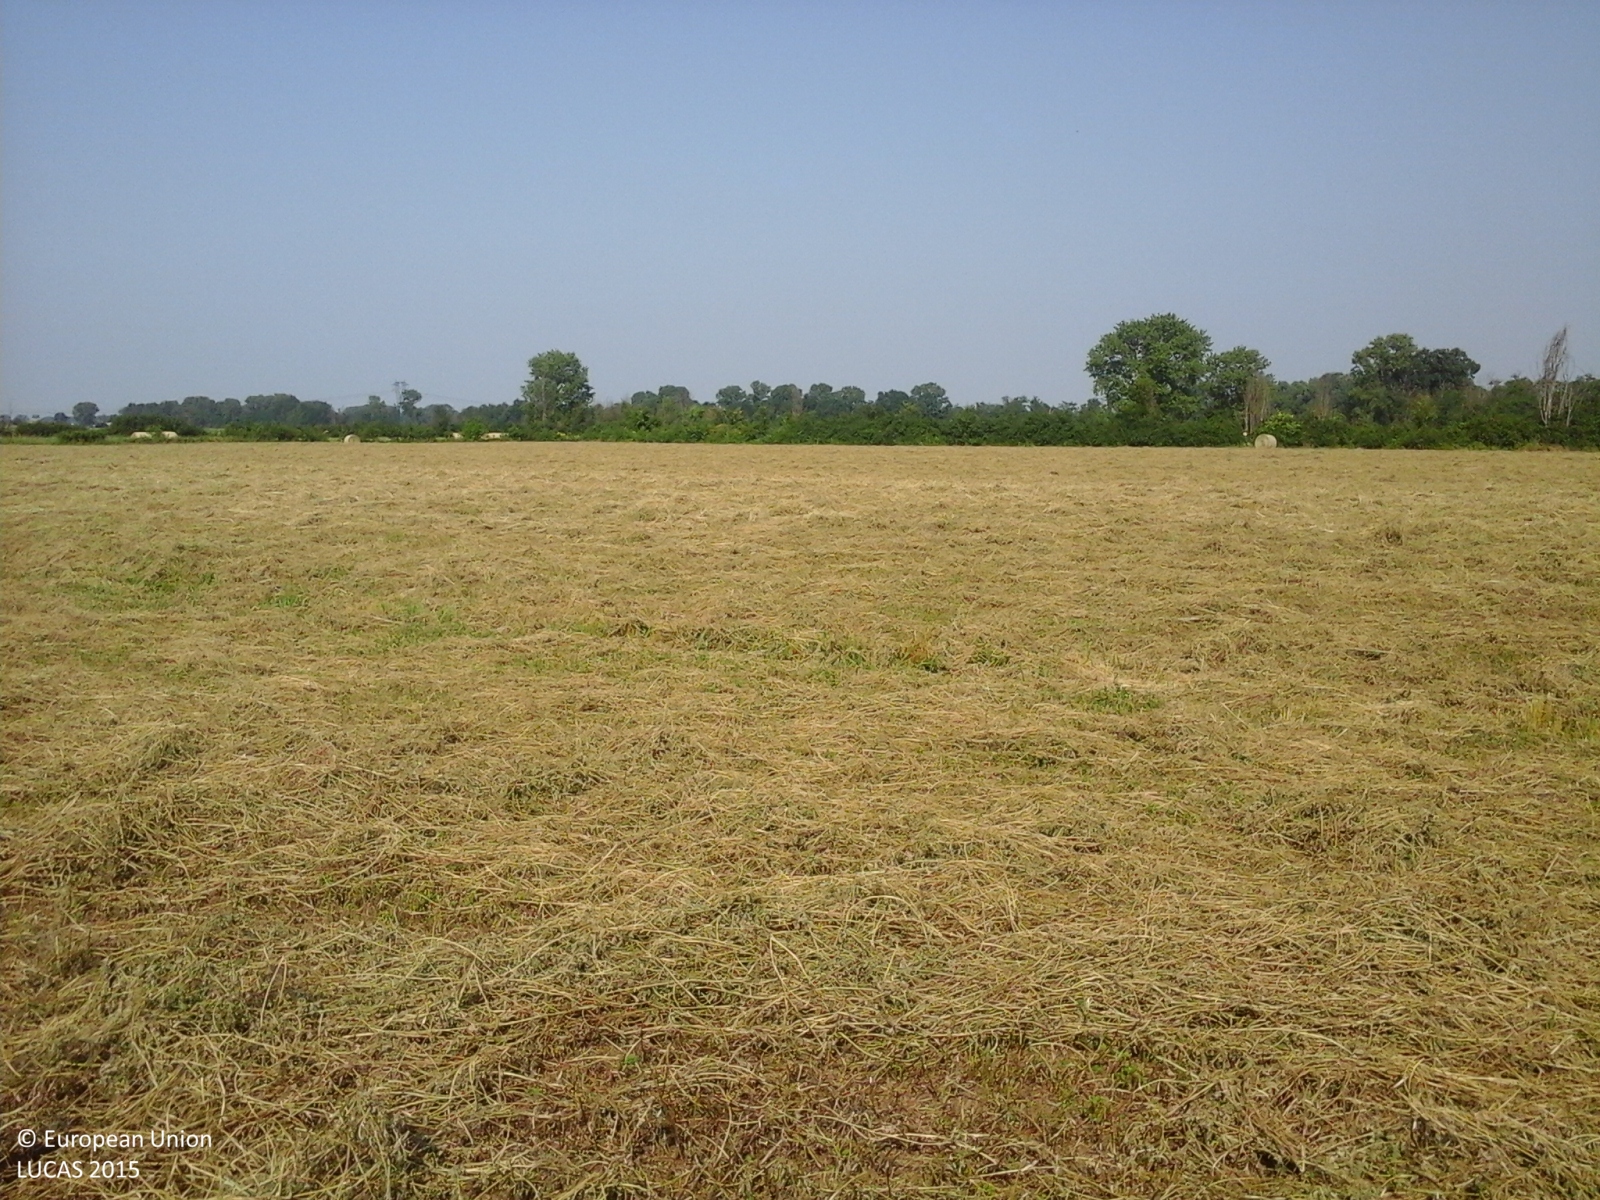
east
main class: Cropland
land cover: Lucerne
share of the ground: > 75 %
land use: Agriculture (excluding fallow land and kitchen gardens)
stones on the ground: < 10 %
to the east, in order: Lucerne; Ditches and canals; Lucerne; Ditches and canals; Lucerne; Ditches and canals; Lucerne; Ditches and canals; Lucerne; Ditches and canals; Abandoned hedges; Lucerne
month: June
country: IT
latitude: 44.8915
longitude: 10.0126
